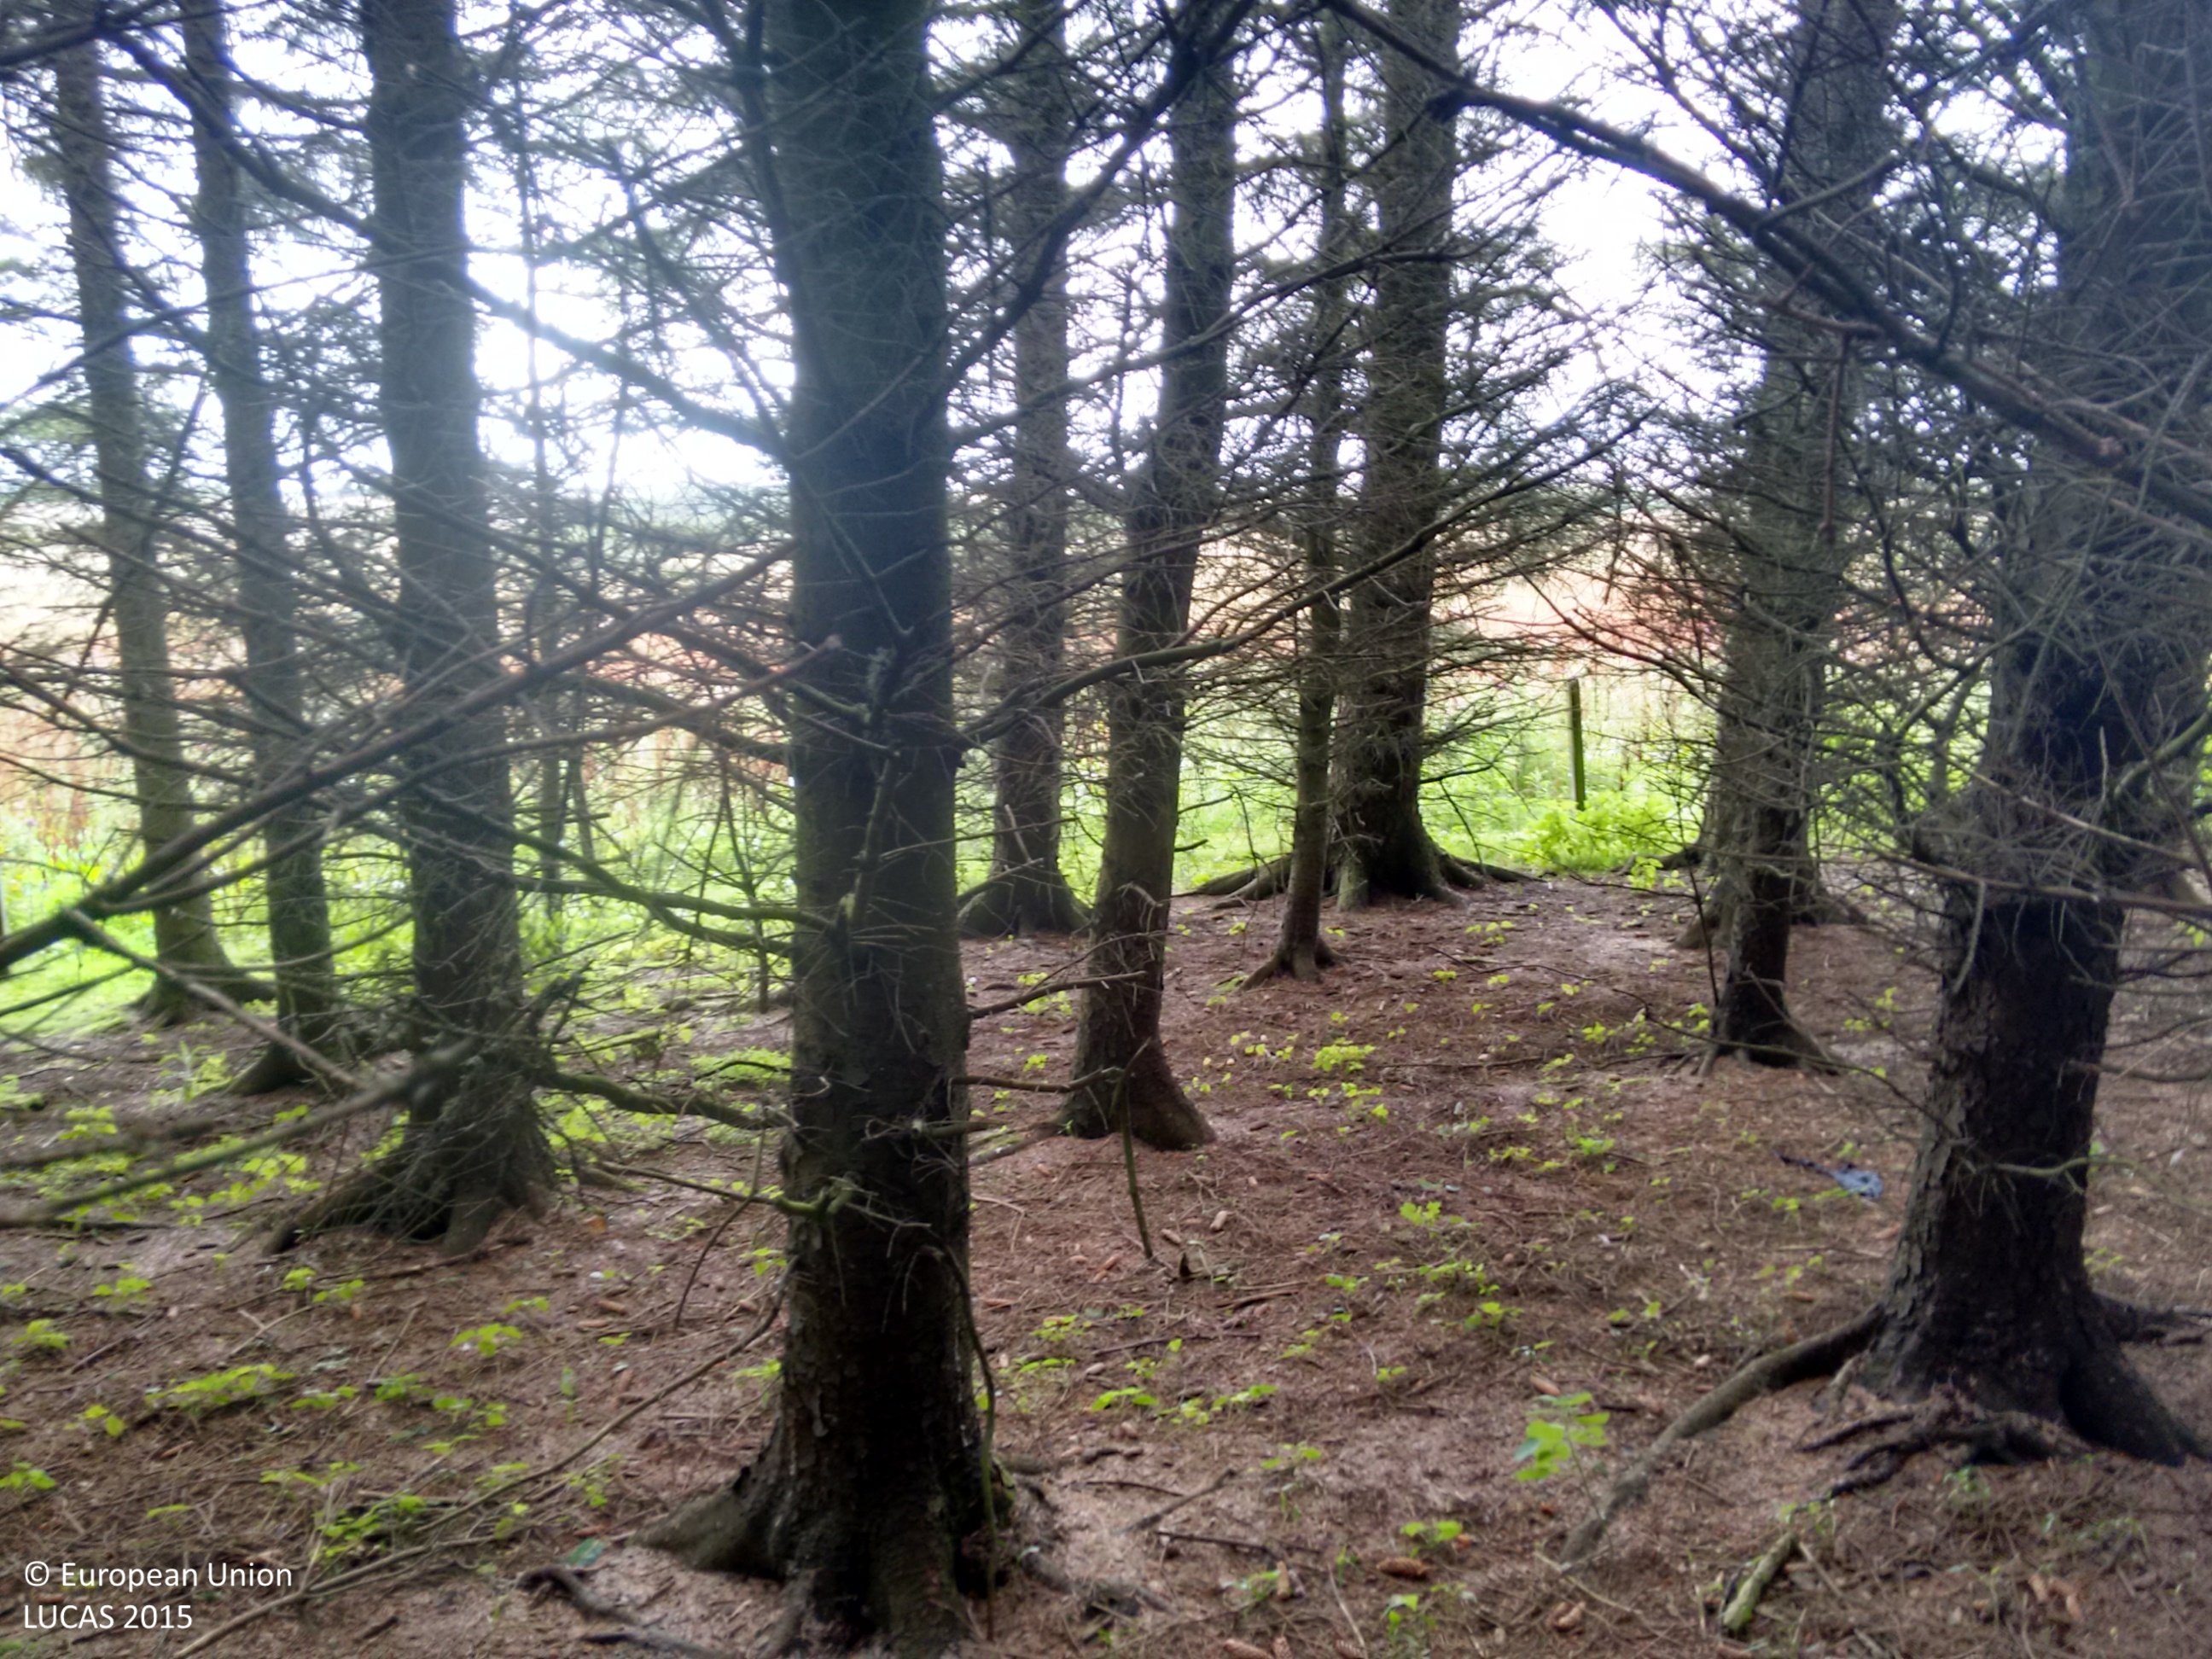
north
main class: Woodland
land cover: Other mixed woodland
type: exotic forest
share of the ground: > 75 %
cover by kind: coniferous forest trees 75 %, broadleaved forest trees 25 %
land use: Agriculture (excluding fallow land and kitchen gardens)
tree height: > 5 m
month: August
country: GB
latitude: 58.3921
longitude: -3.1455
